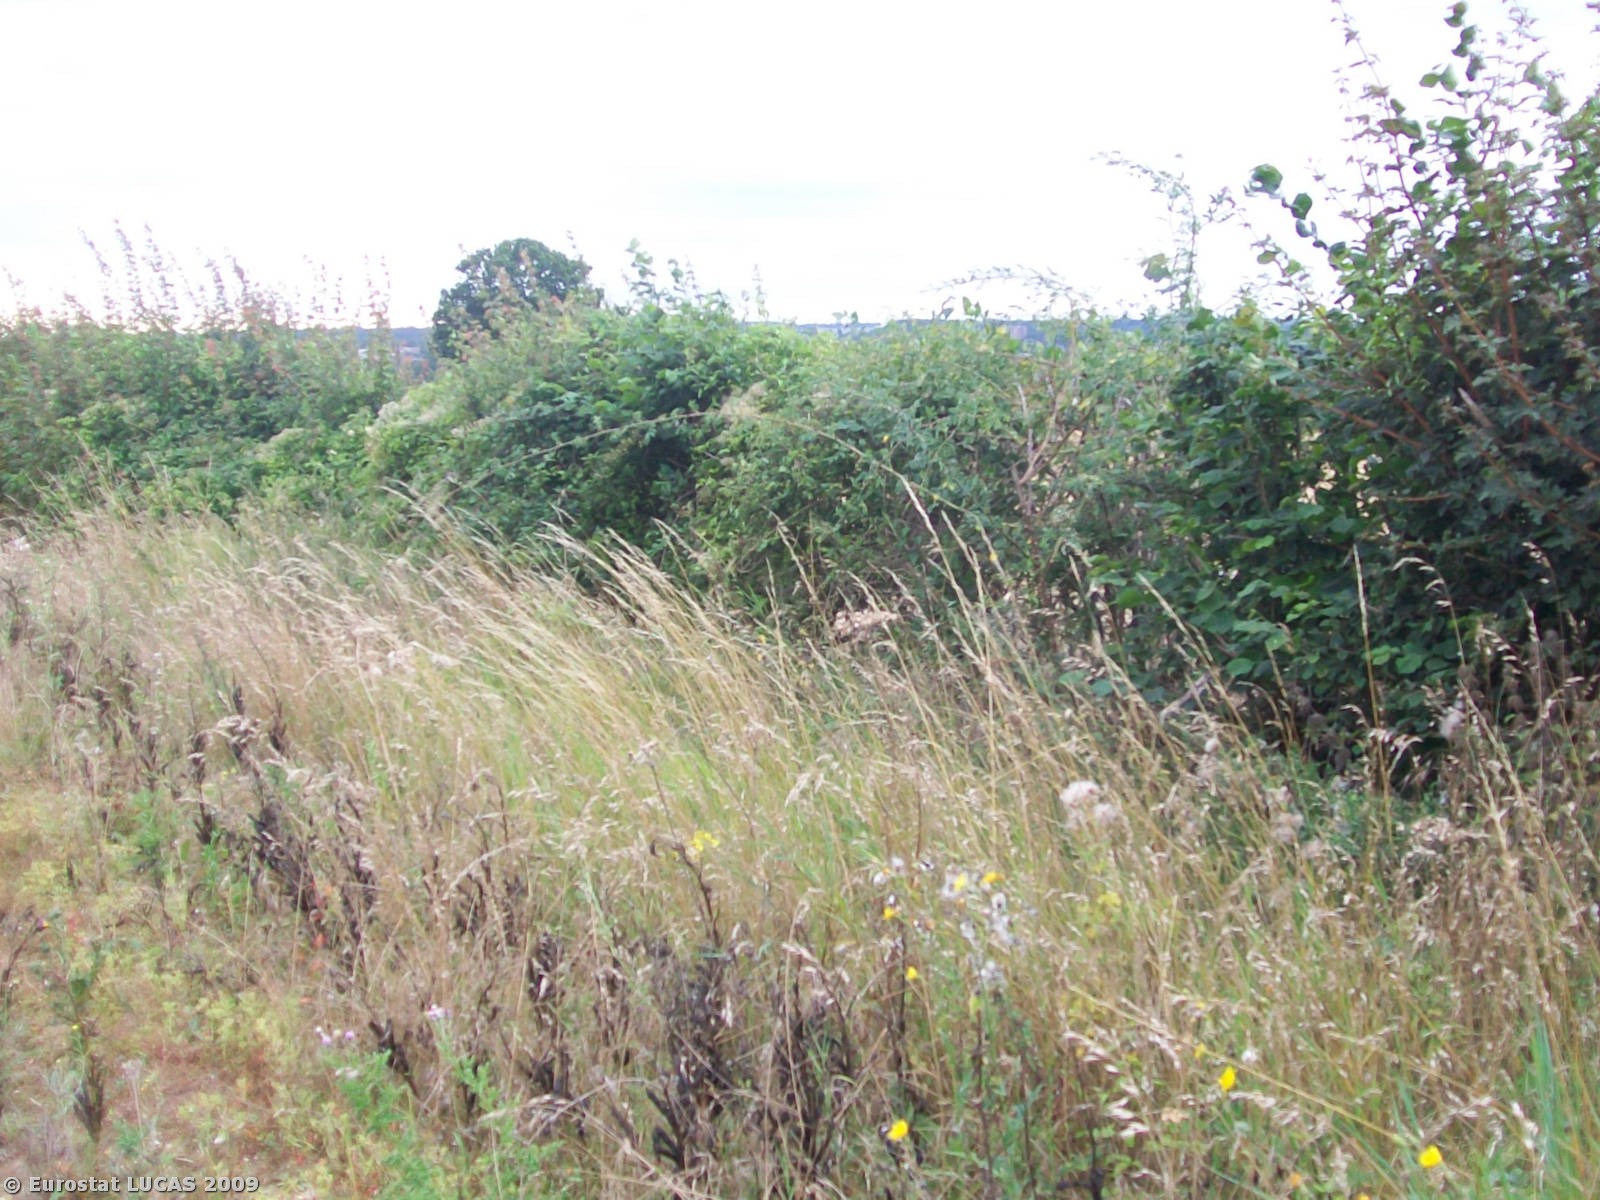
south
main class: Cropland
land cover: Dry pulses
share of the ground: > 75 %
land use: Agriculture (excluding fallow land and kitchen gardens)
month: August
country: GB
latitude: 51.8015
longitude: 0.1219
